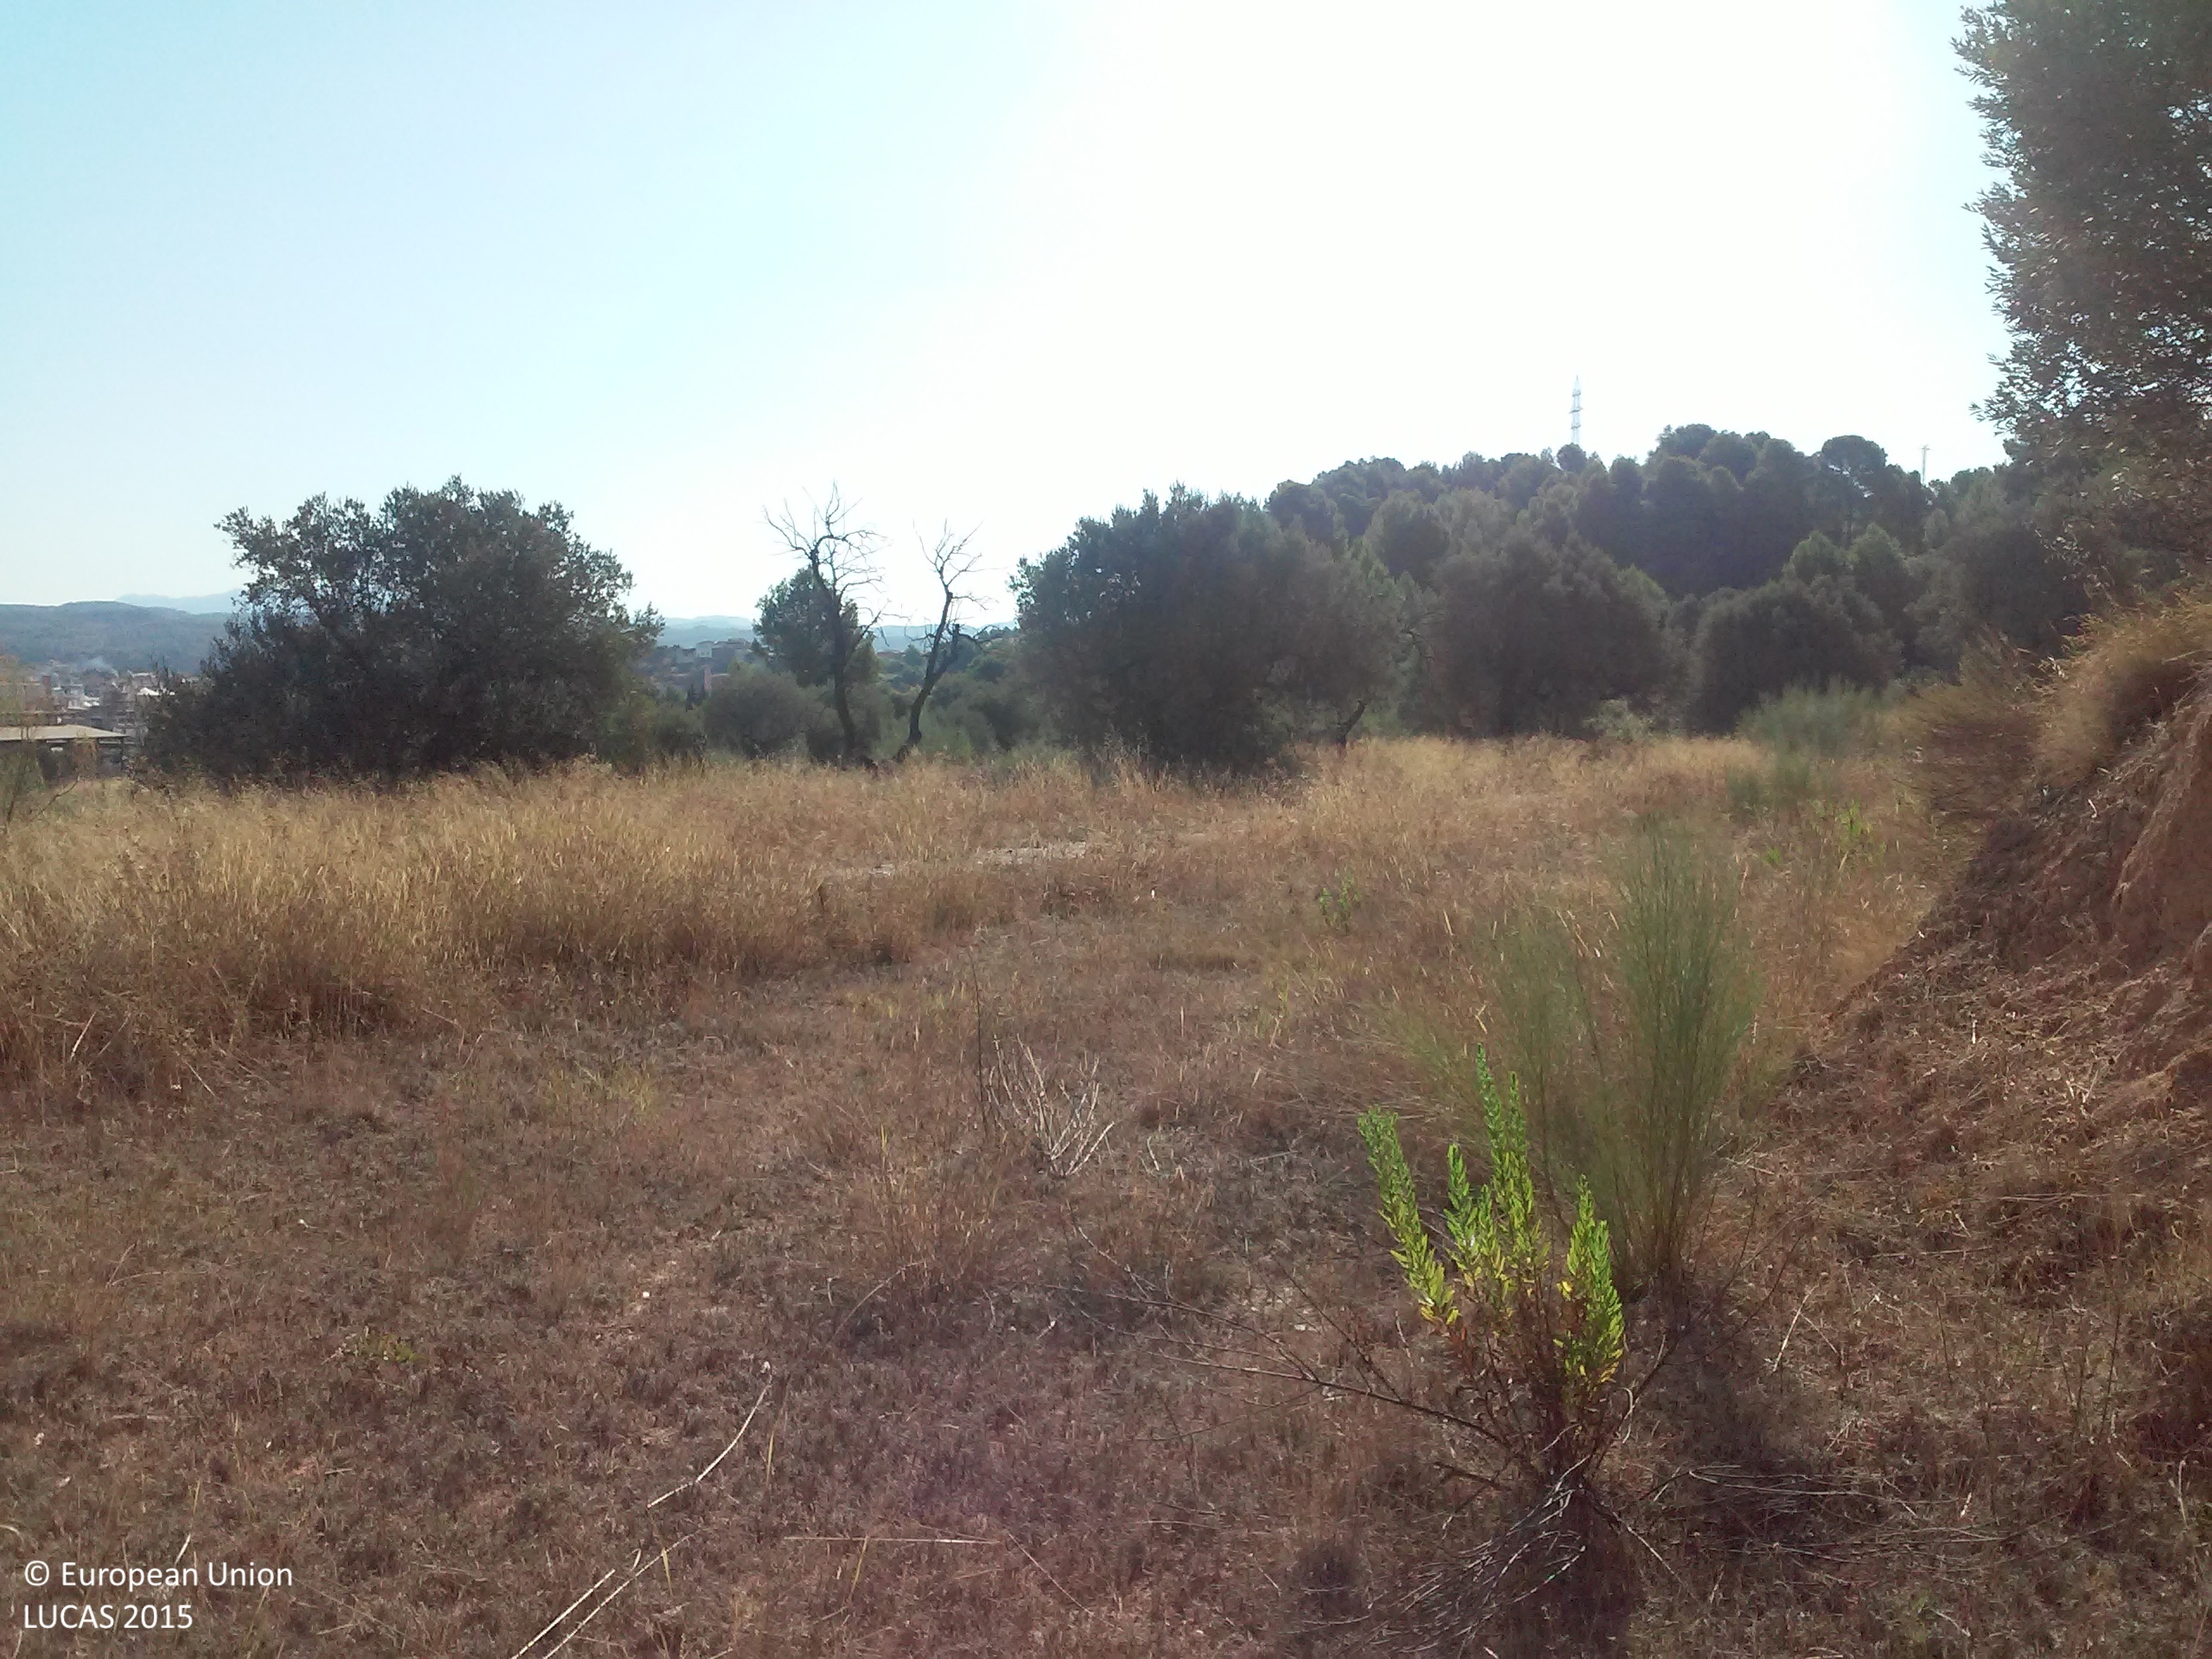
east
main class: Grassland
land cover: Grassland without tree/shrub cover
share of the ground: 25 - 50 %
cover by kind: herbaceous plants 95 %, shrubs 5 %
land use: Semi-natural and natural areas not in use
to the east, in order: Grassland without tree/shrub cover; Tracks; Grassland with sparse tree/shrub cover; Groves; Shrubland with sparse tree cover; Groves; Dry stone walls; Grassland without tree/shrub cover; Groves; Grassland with sparse tree/shrub cover; Tracks; Shrubland without tree cover
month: August
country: ES
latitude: 41.2277
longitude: 0.5302
